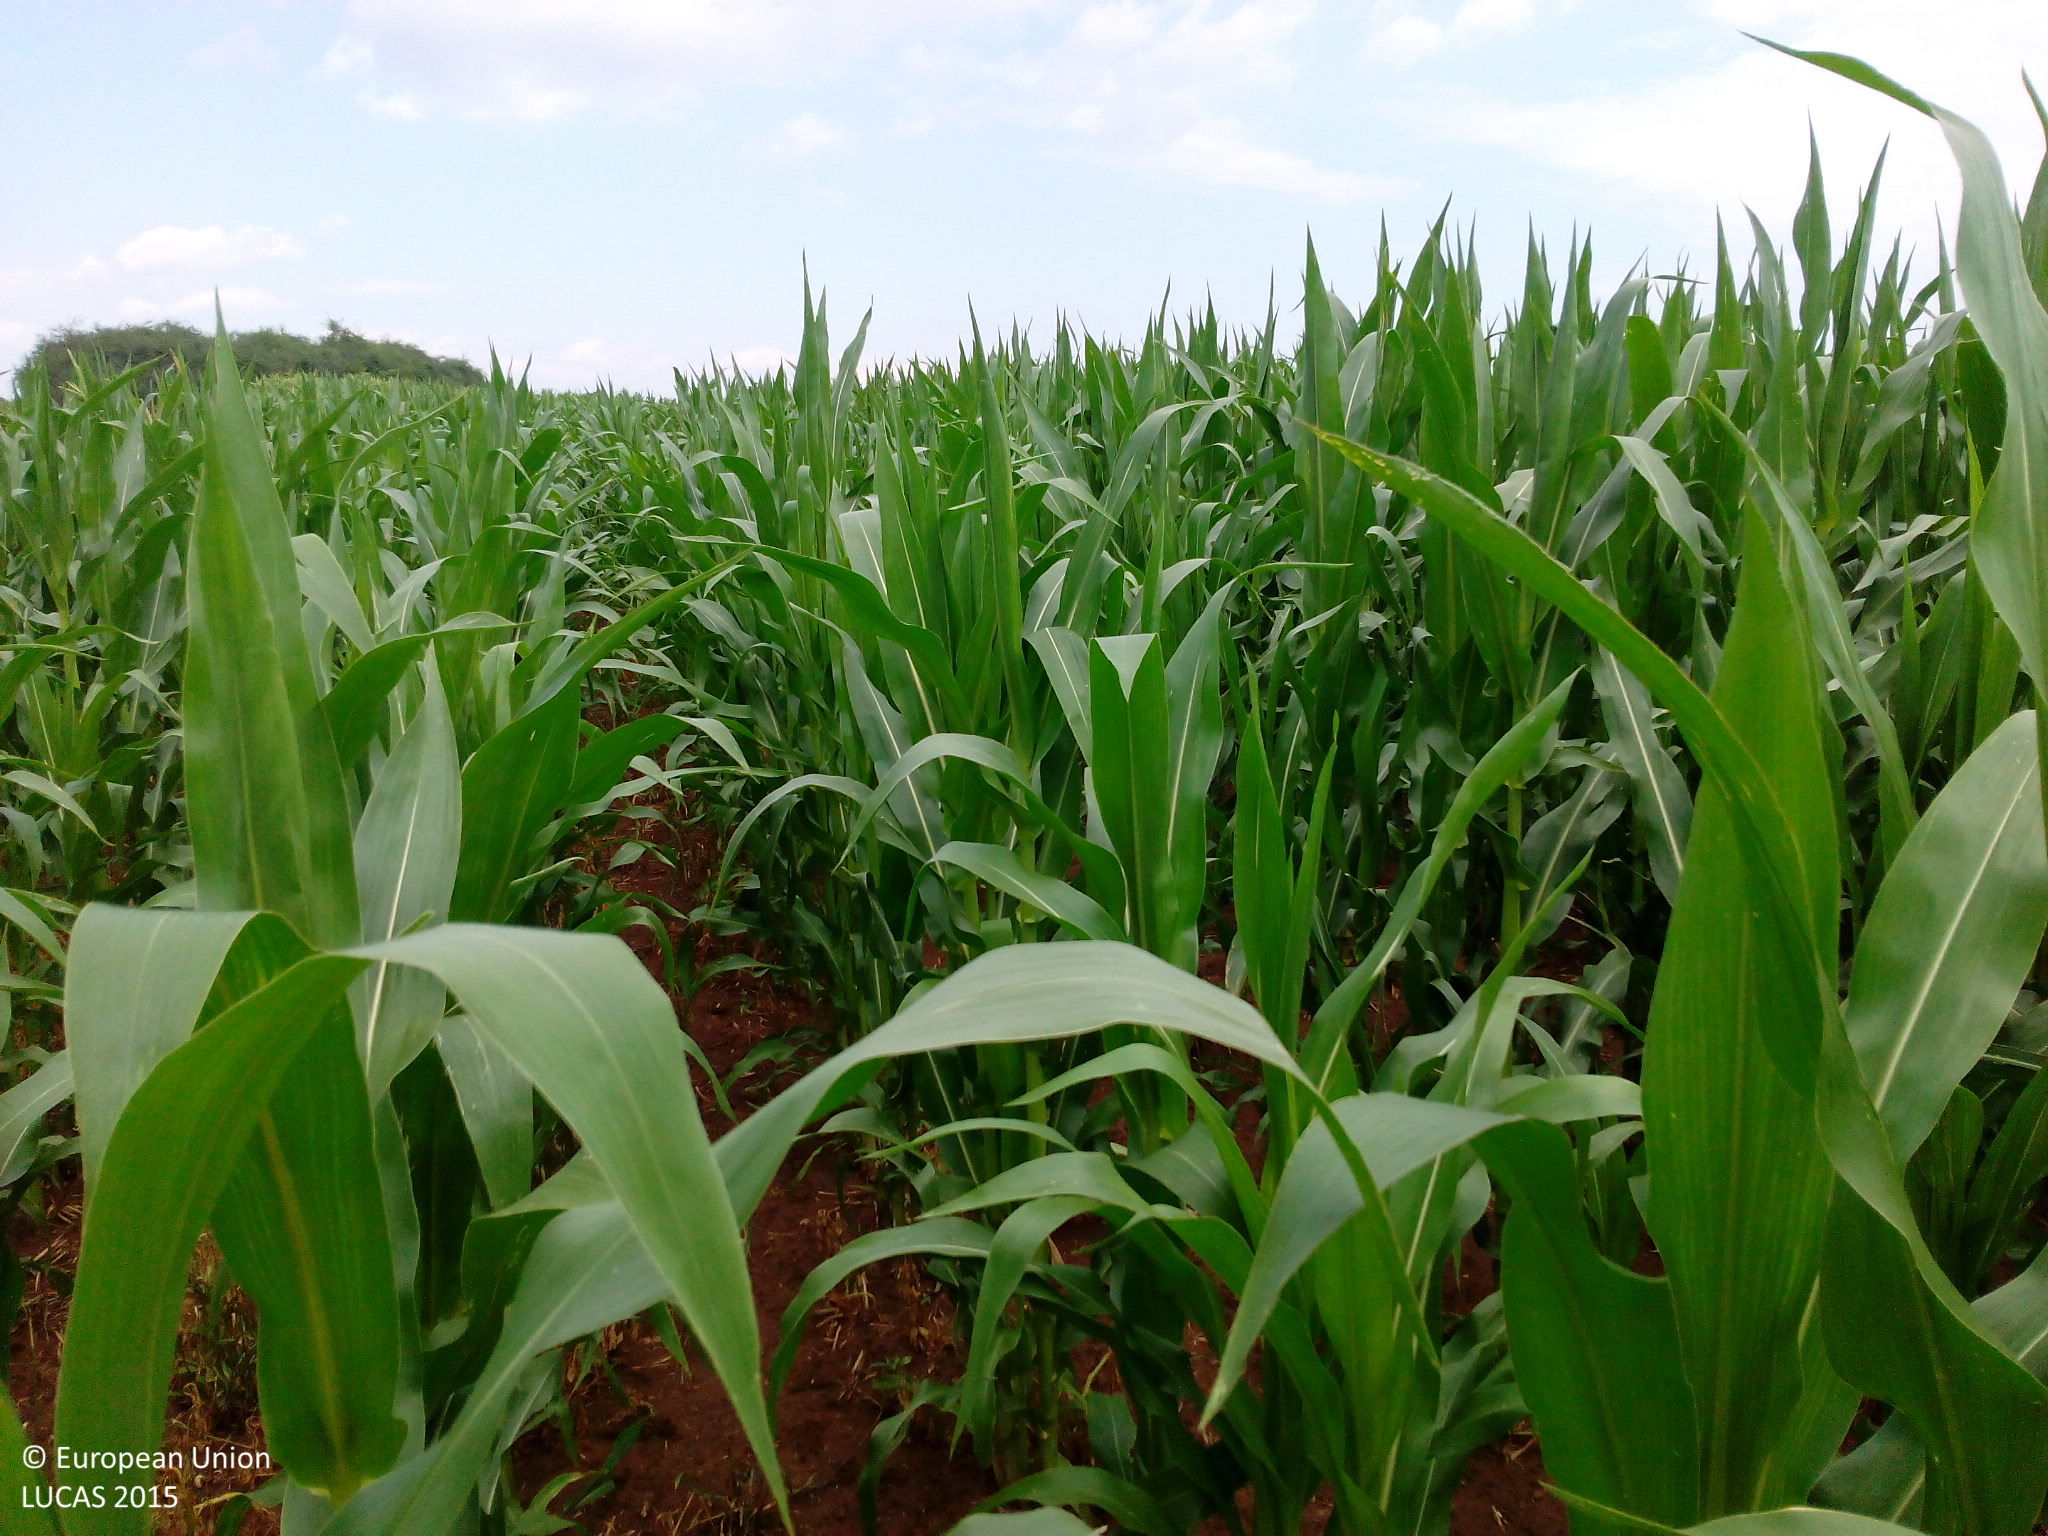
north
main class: Cropland
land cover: Maize
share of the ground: > 75 %
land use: Agriculture (excluding fallow land and kitchen gardens)
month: July
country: DE
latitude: 49.4971
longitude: 10.9247
